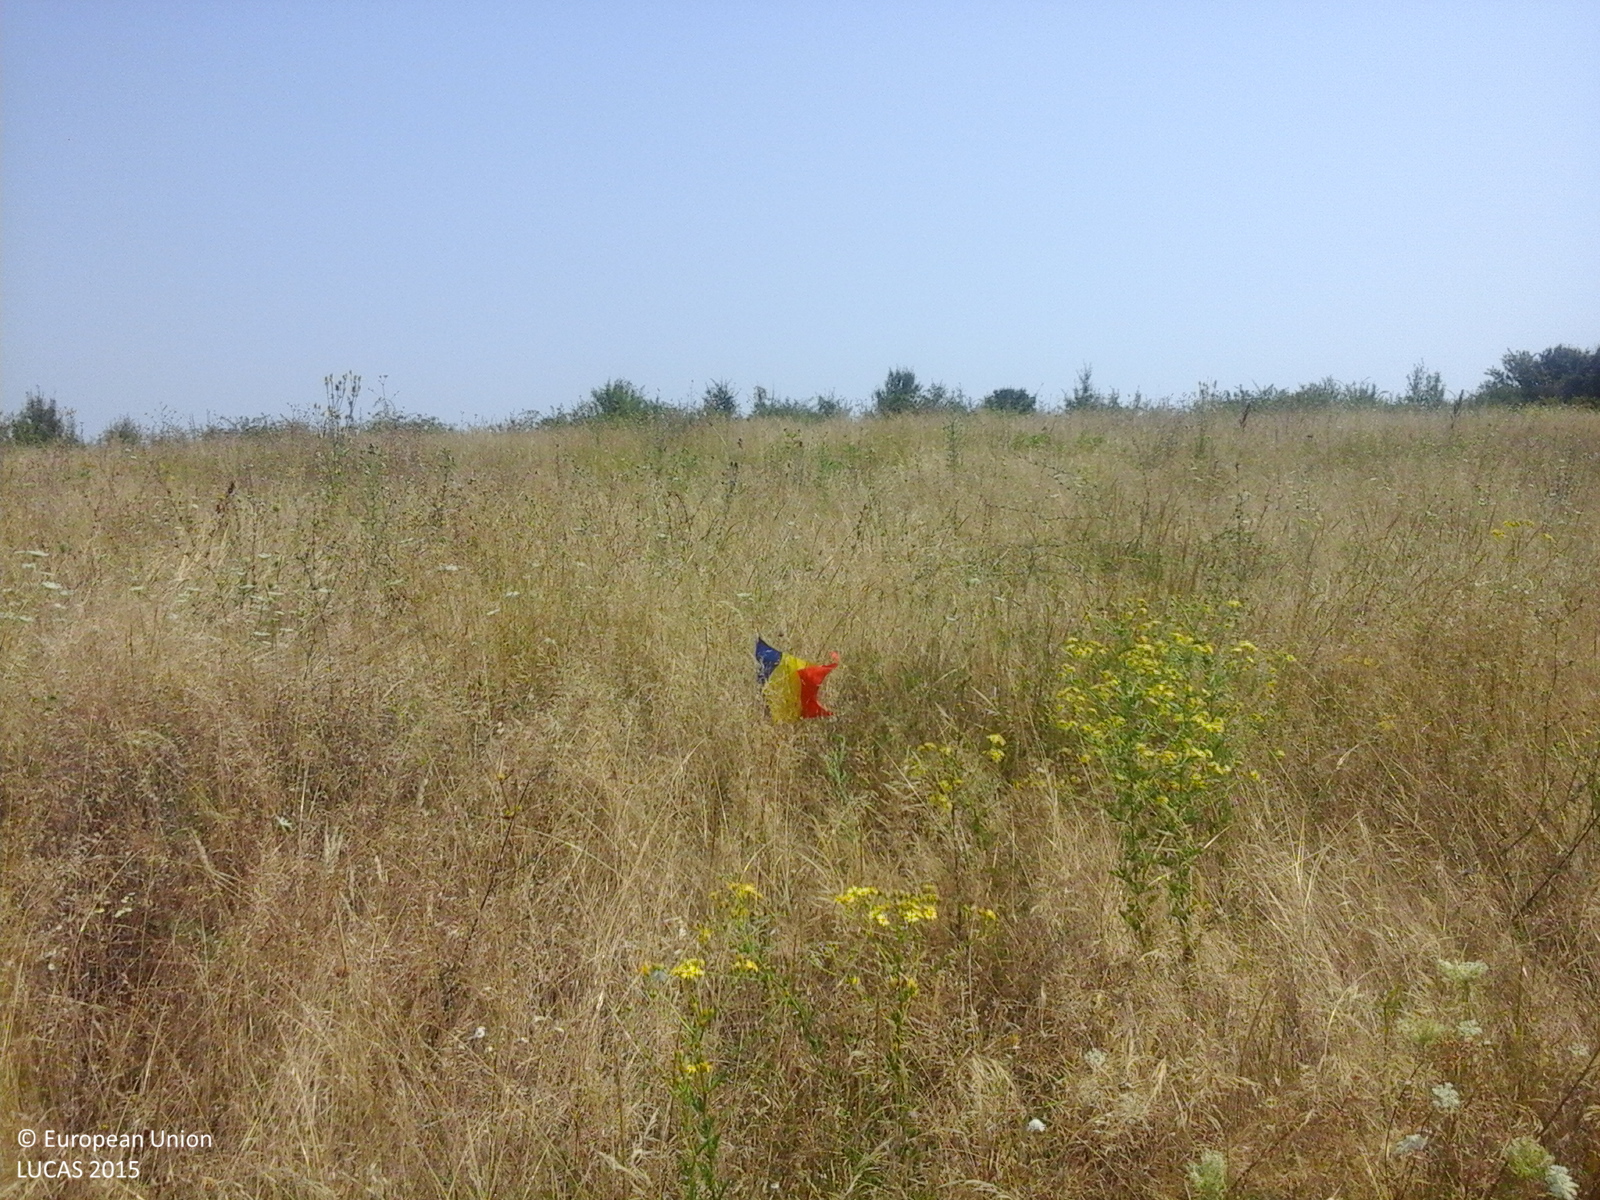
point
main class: Grassland
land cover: Grassland without tree/shrub cover
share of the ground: > 75 %
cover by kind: herbaceous plants 100 %
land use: Agriculture (excluding fallow land and kitchen gardens)
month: August
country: RO
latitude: 44.5738
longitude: 23.1065
